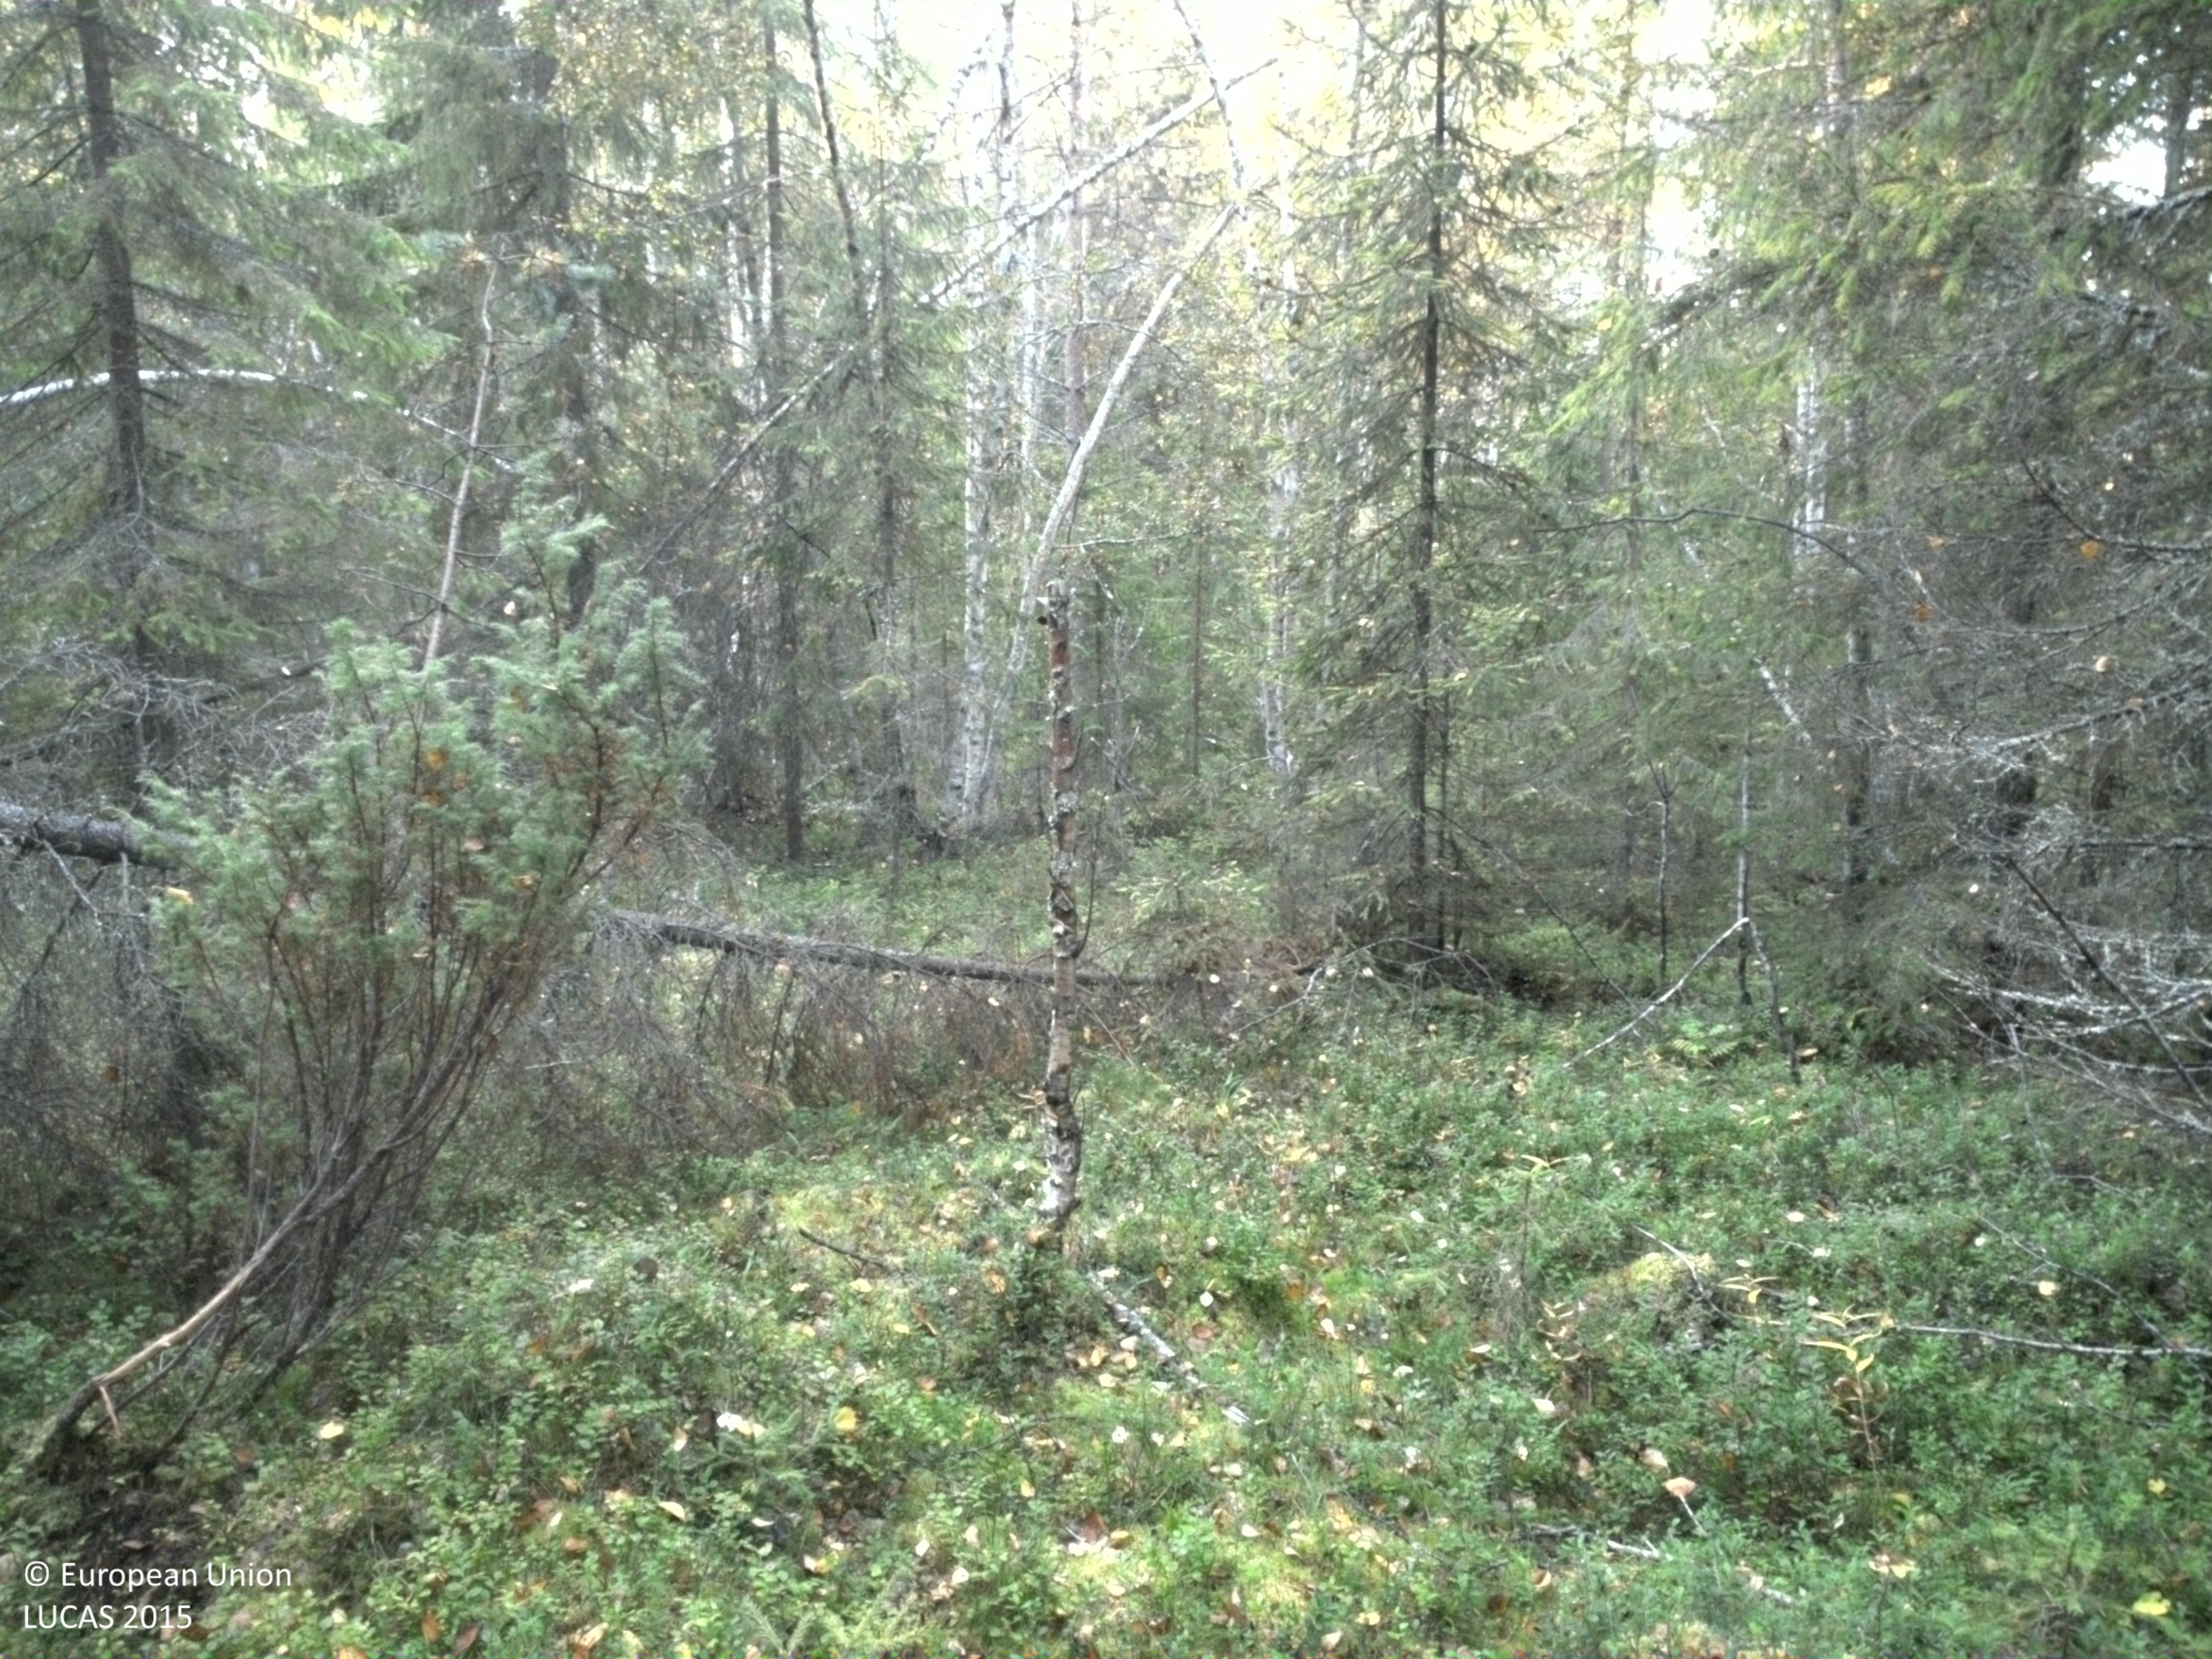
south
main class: Woodland
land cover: Spruce dominated mixed woodland
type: boreal forest
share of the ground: 25 - 50 %
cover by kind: shrubs 45 %, coniferous forest trees 30 %, broadleaved forest trees 20 %, lichens and mosses 5 %
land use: Forestry
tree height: > 5 m
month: September
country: SE
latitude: 65.6059
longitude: 22.2841
